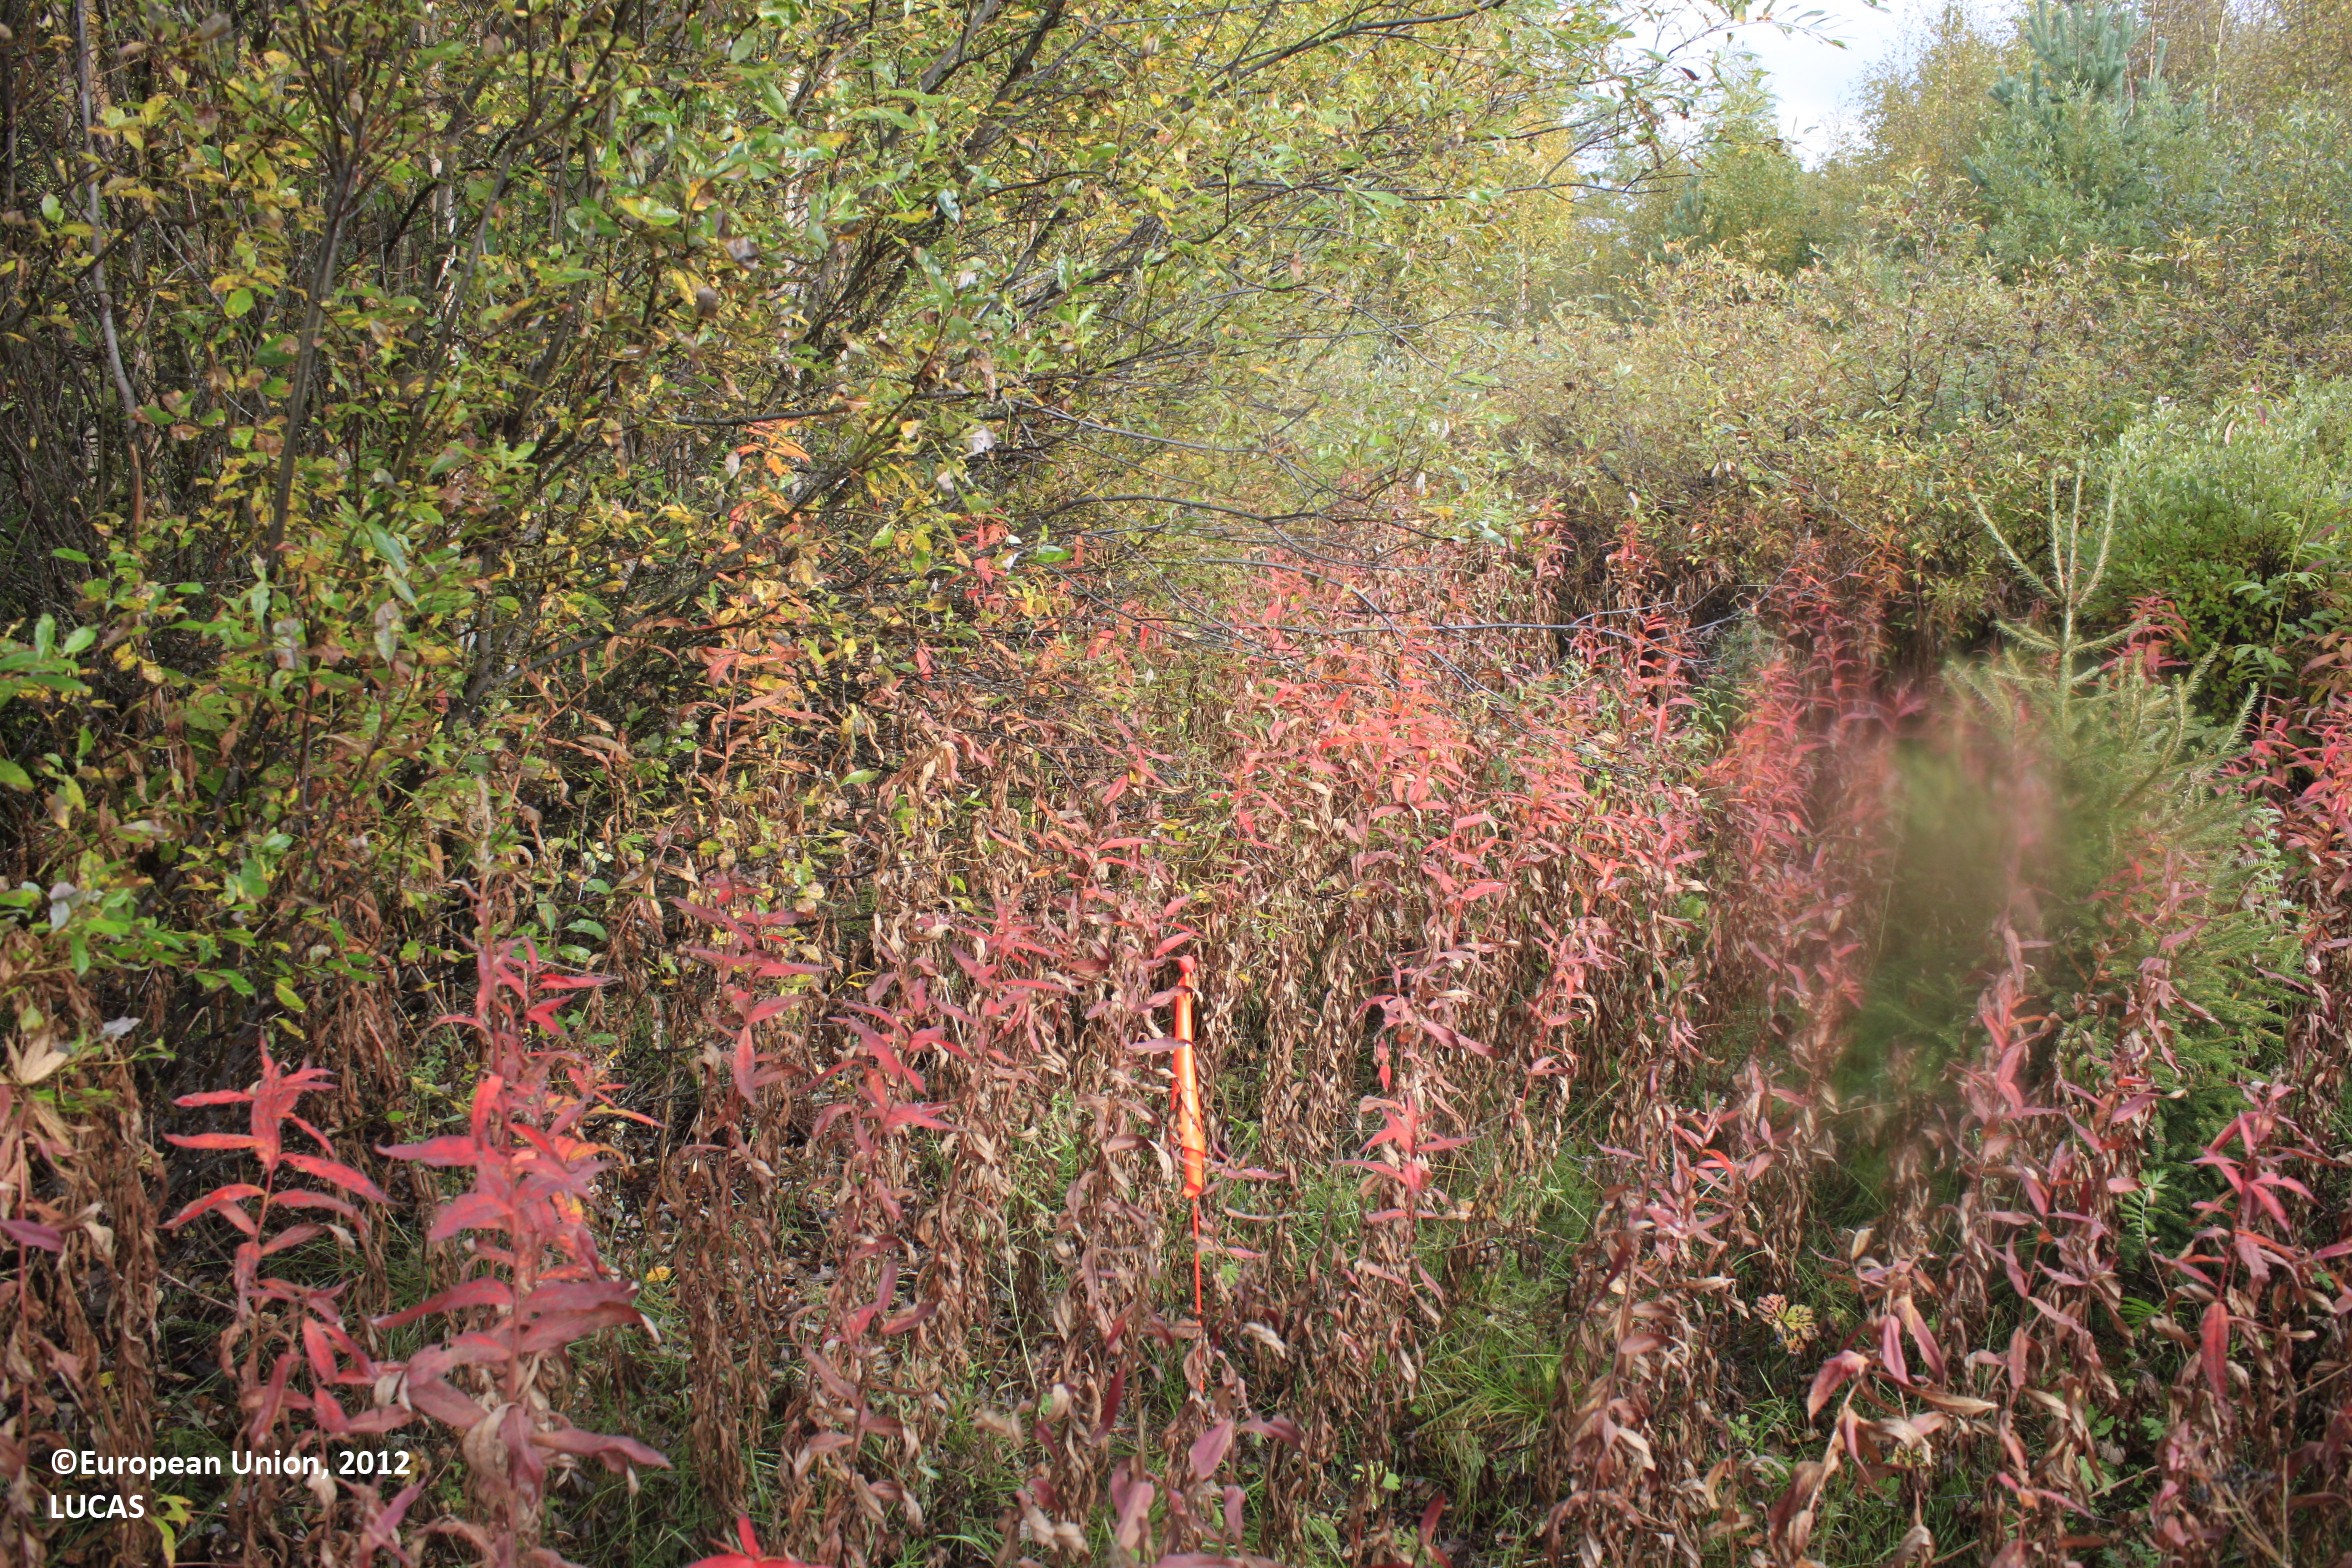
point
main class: Shrubland
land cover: Shrubland with sparse tree cover
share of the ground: > 75 %
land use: Semi-natural and natural areas not in use
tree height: > 5 m
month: September
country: FI
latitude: 65.5755
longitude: 26.5966
